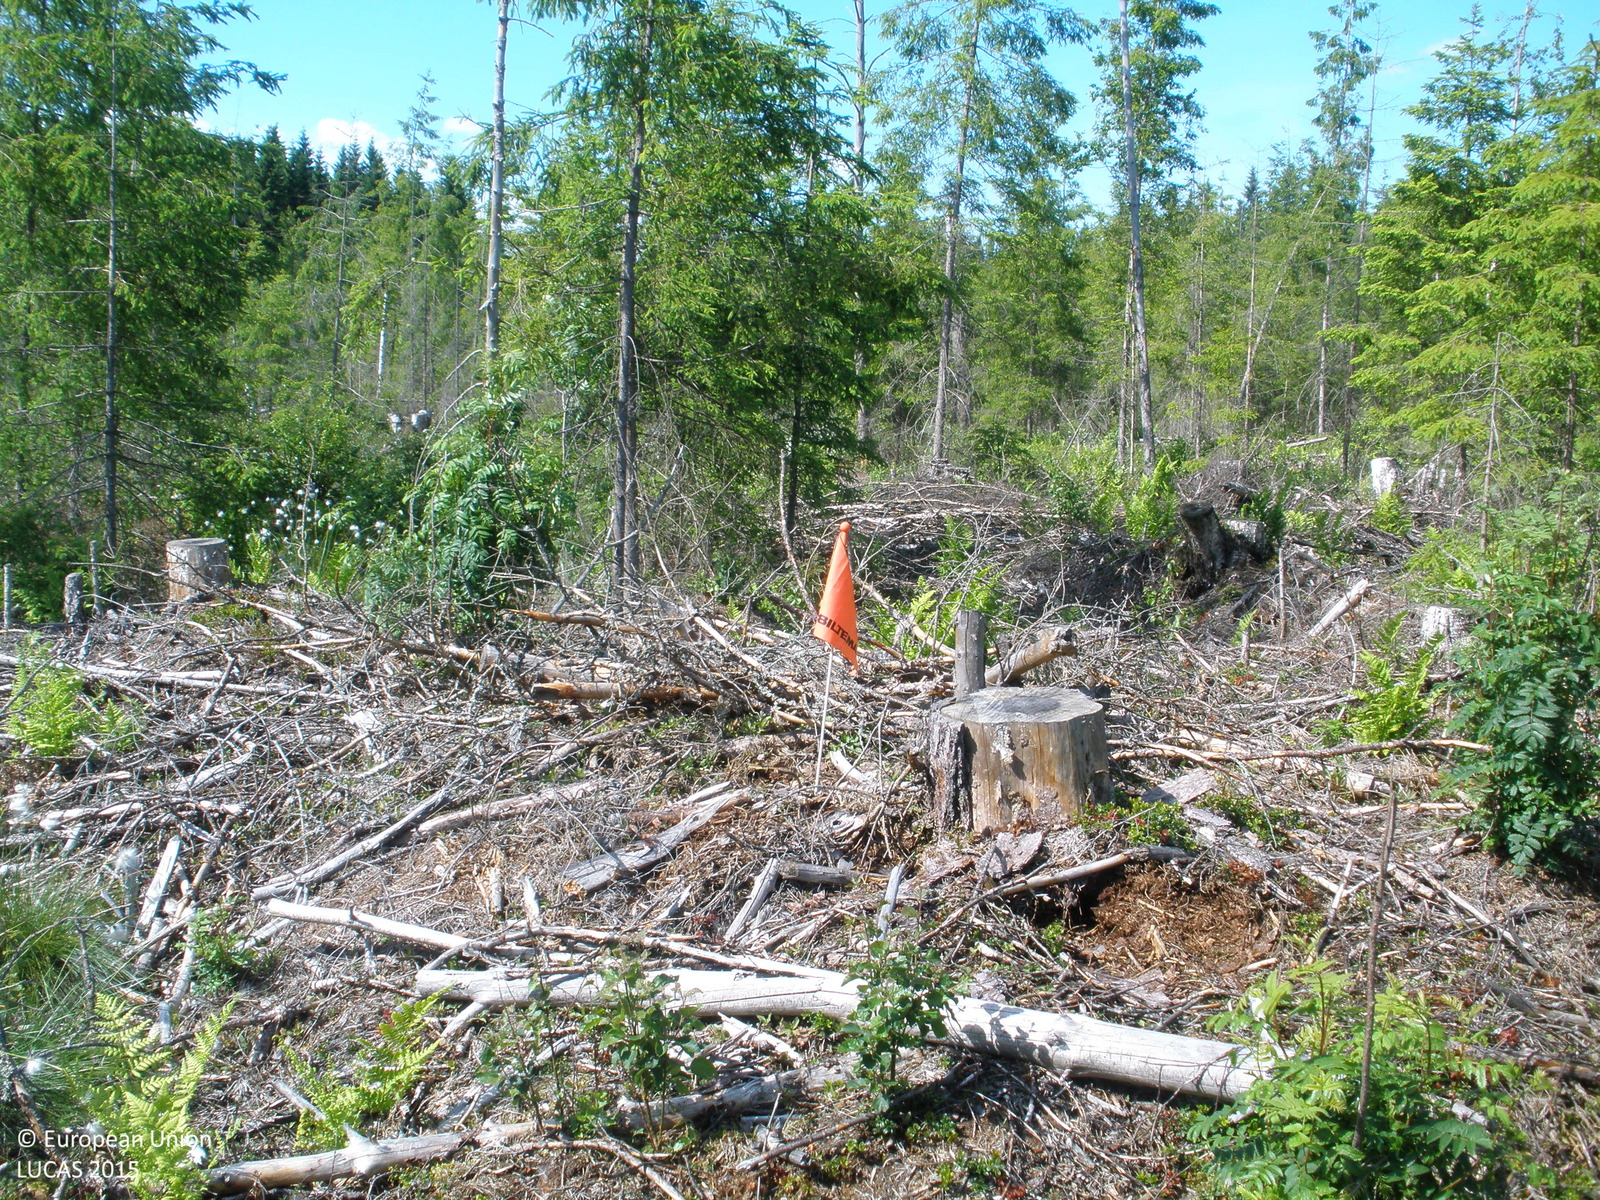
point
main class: Woodland
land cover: Spruce dominated mixed woodland
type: boreal forest
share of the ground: 50 - 75 %
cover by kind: coniferous forest trees 25 %, broadleaved forest trees 25 %, unconsolidated bare surface 25 %, herbaceous plants 10 %, consolidated bare surface 10 %
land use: Forestry
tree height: < 5 m
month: June
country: FI
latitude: 61.0628
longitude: 24.6493
